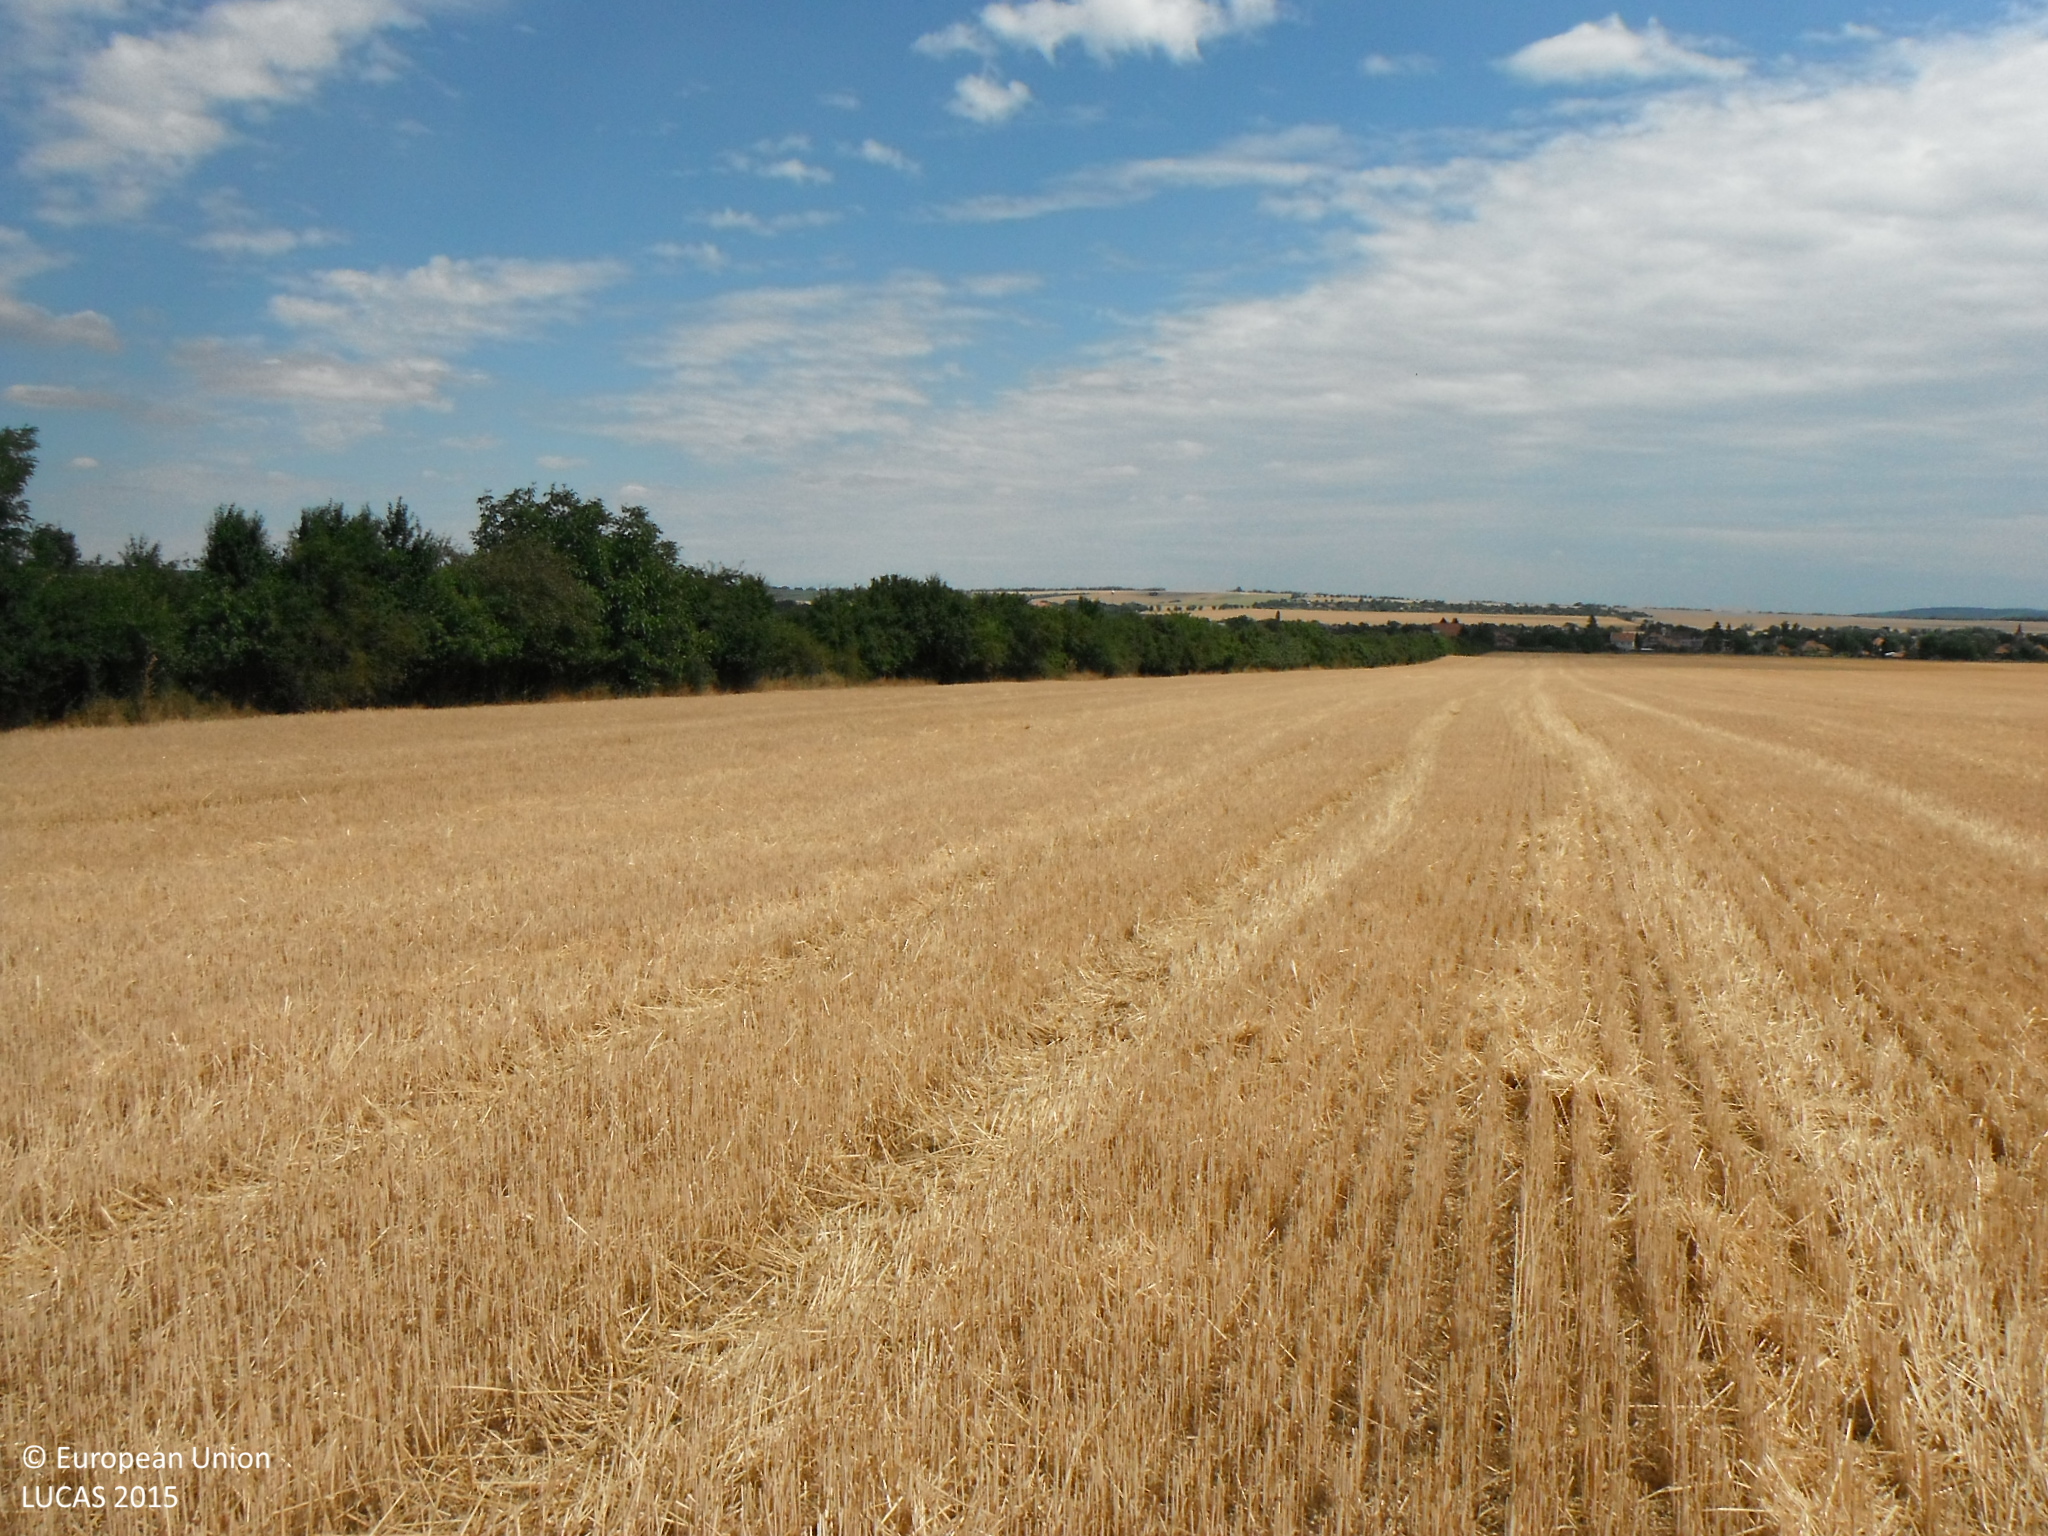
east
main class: Cropland
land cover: Common wheat
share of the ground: > 75 %
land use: Agriculture (excluding fallow land and kitchen gardens)
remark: Harvested field
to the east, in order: Common wheat; Shrubland with sparse tree cover; Tracks; Shrubland with sparse tree cover; Common wheat; Rape and turnip rape
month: July
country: SK
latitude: 48.1488
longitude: 18.2537
